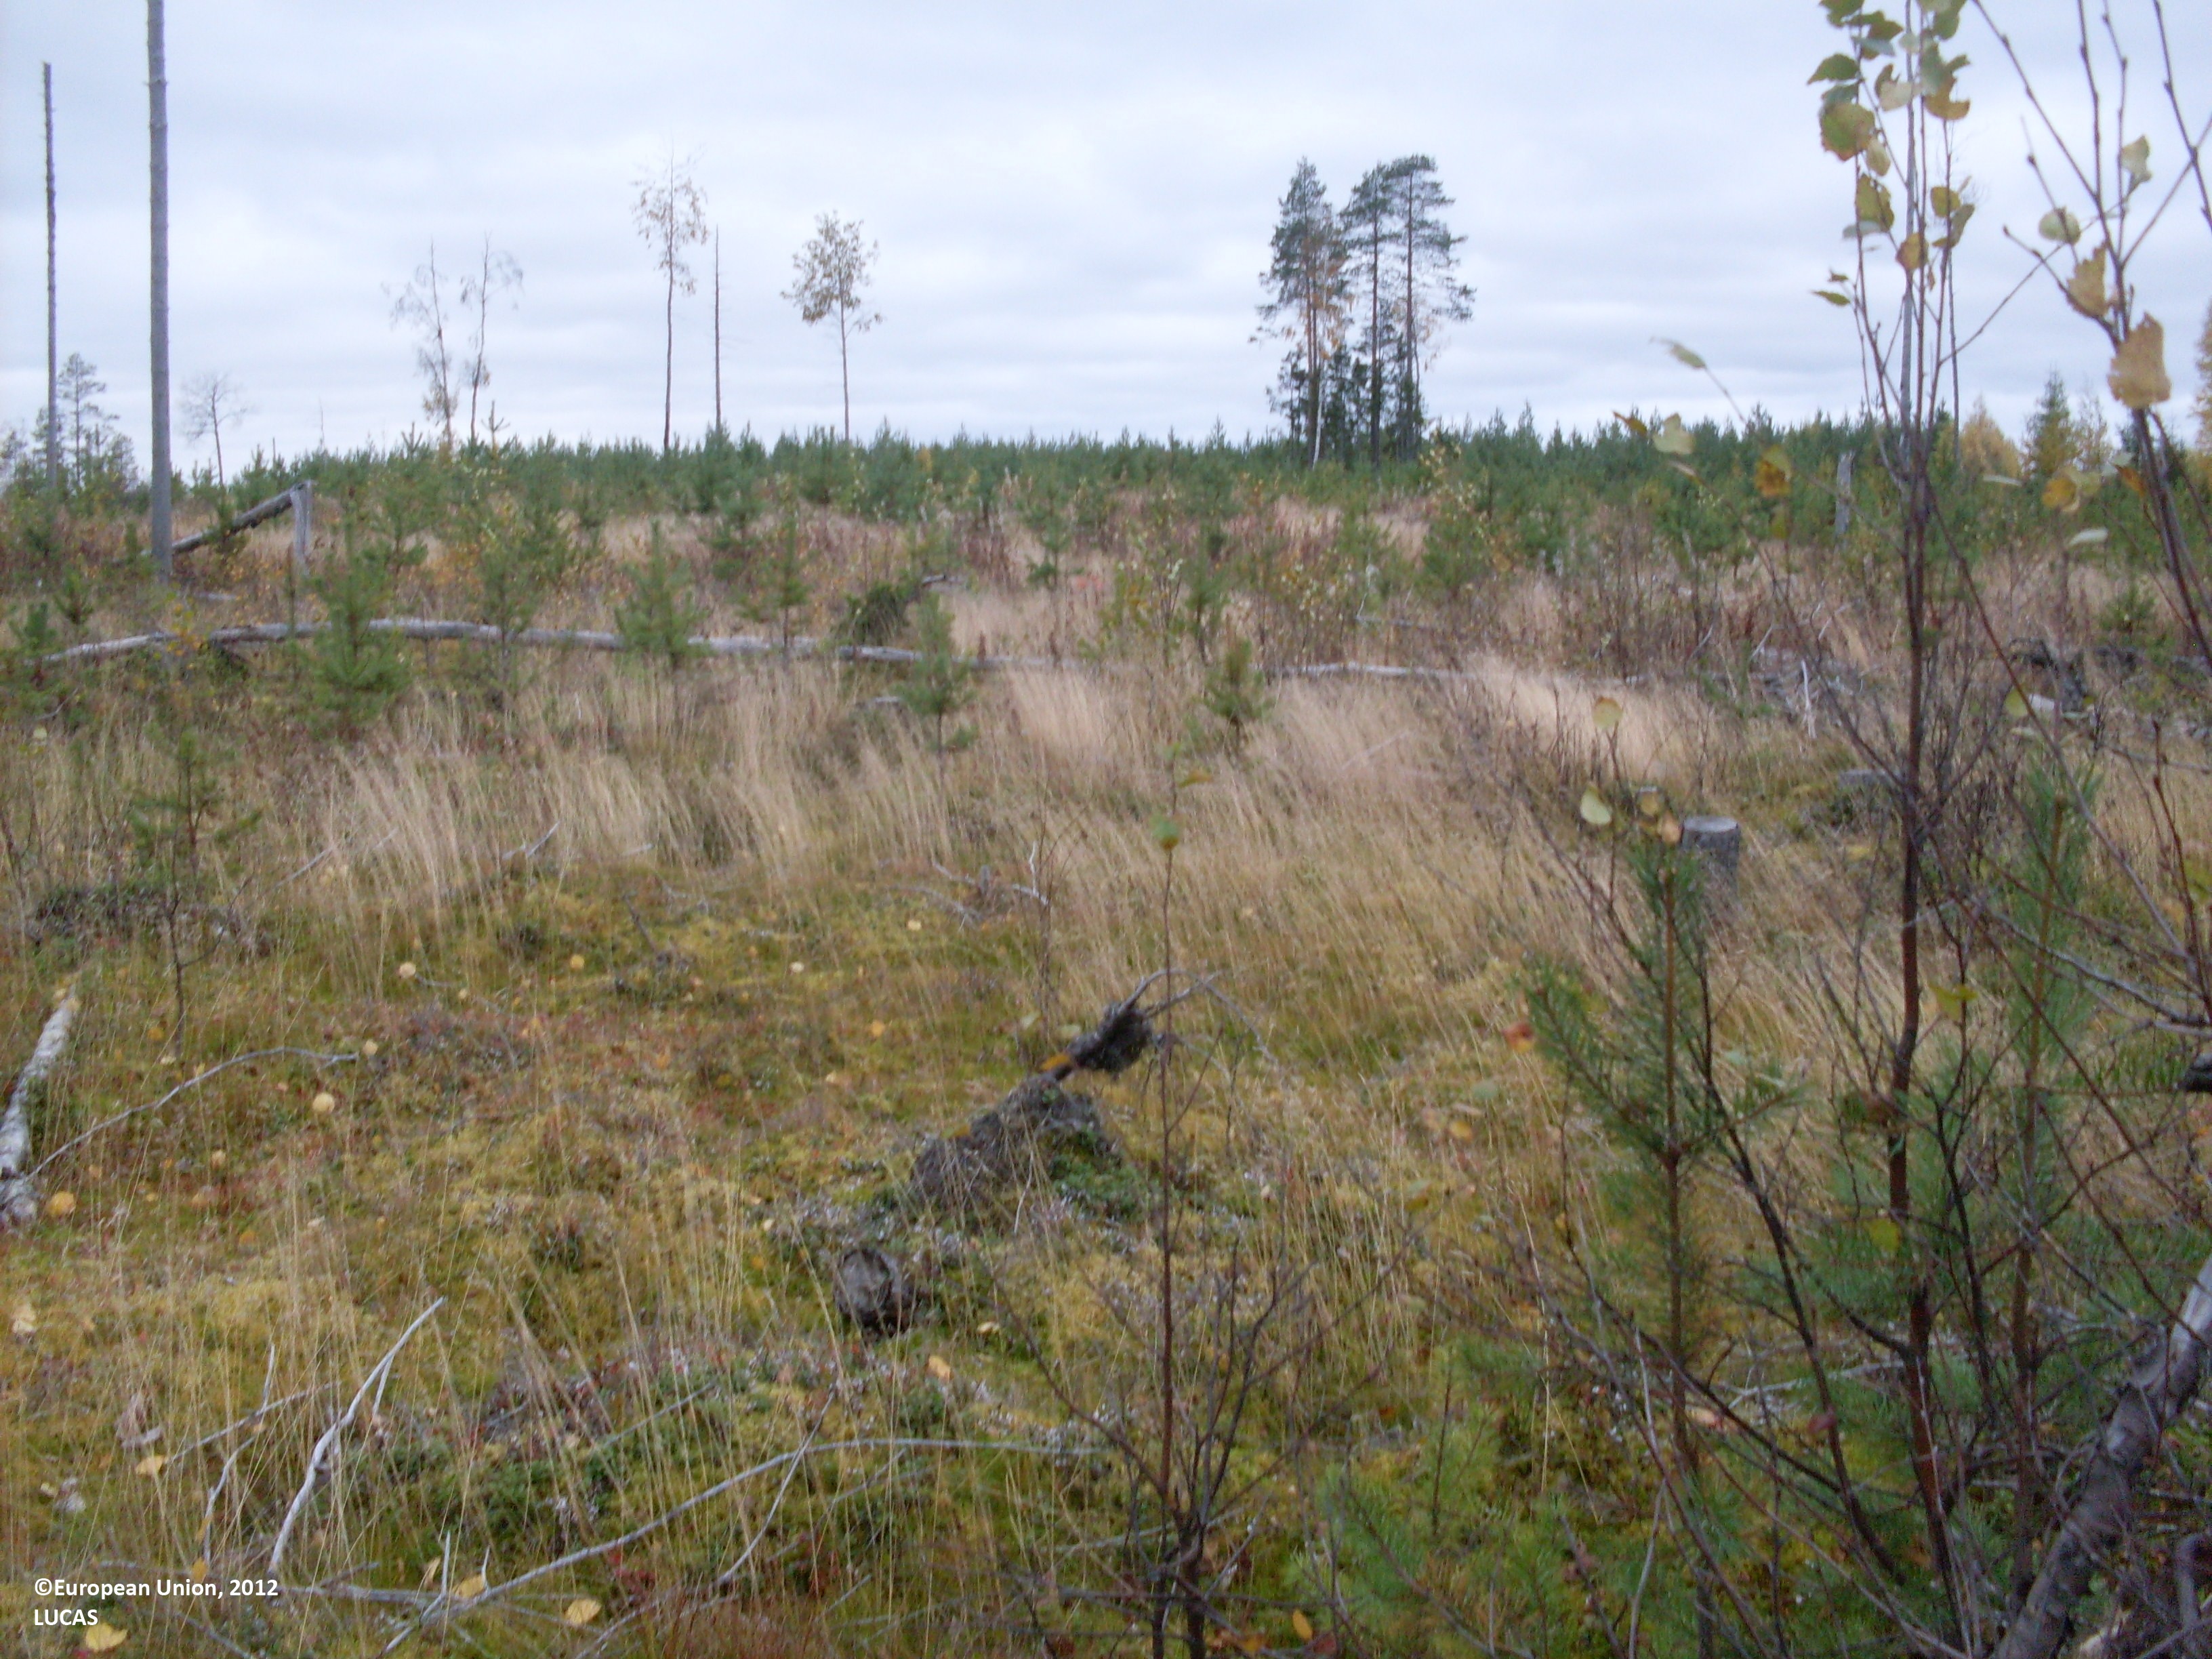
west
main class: Shrubland
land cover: Shrubland with sparse tree cover
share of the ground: 50 - 75 %
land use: Forestry
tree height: > 5 m
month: September
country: FI
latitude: 64.4147
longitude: 30.0141
